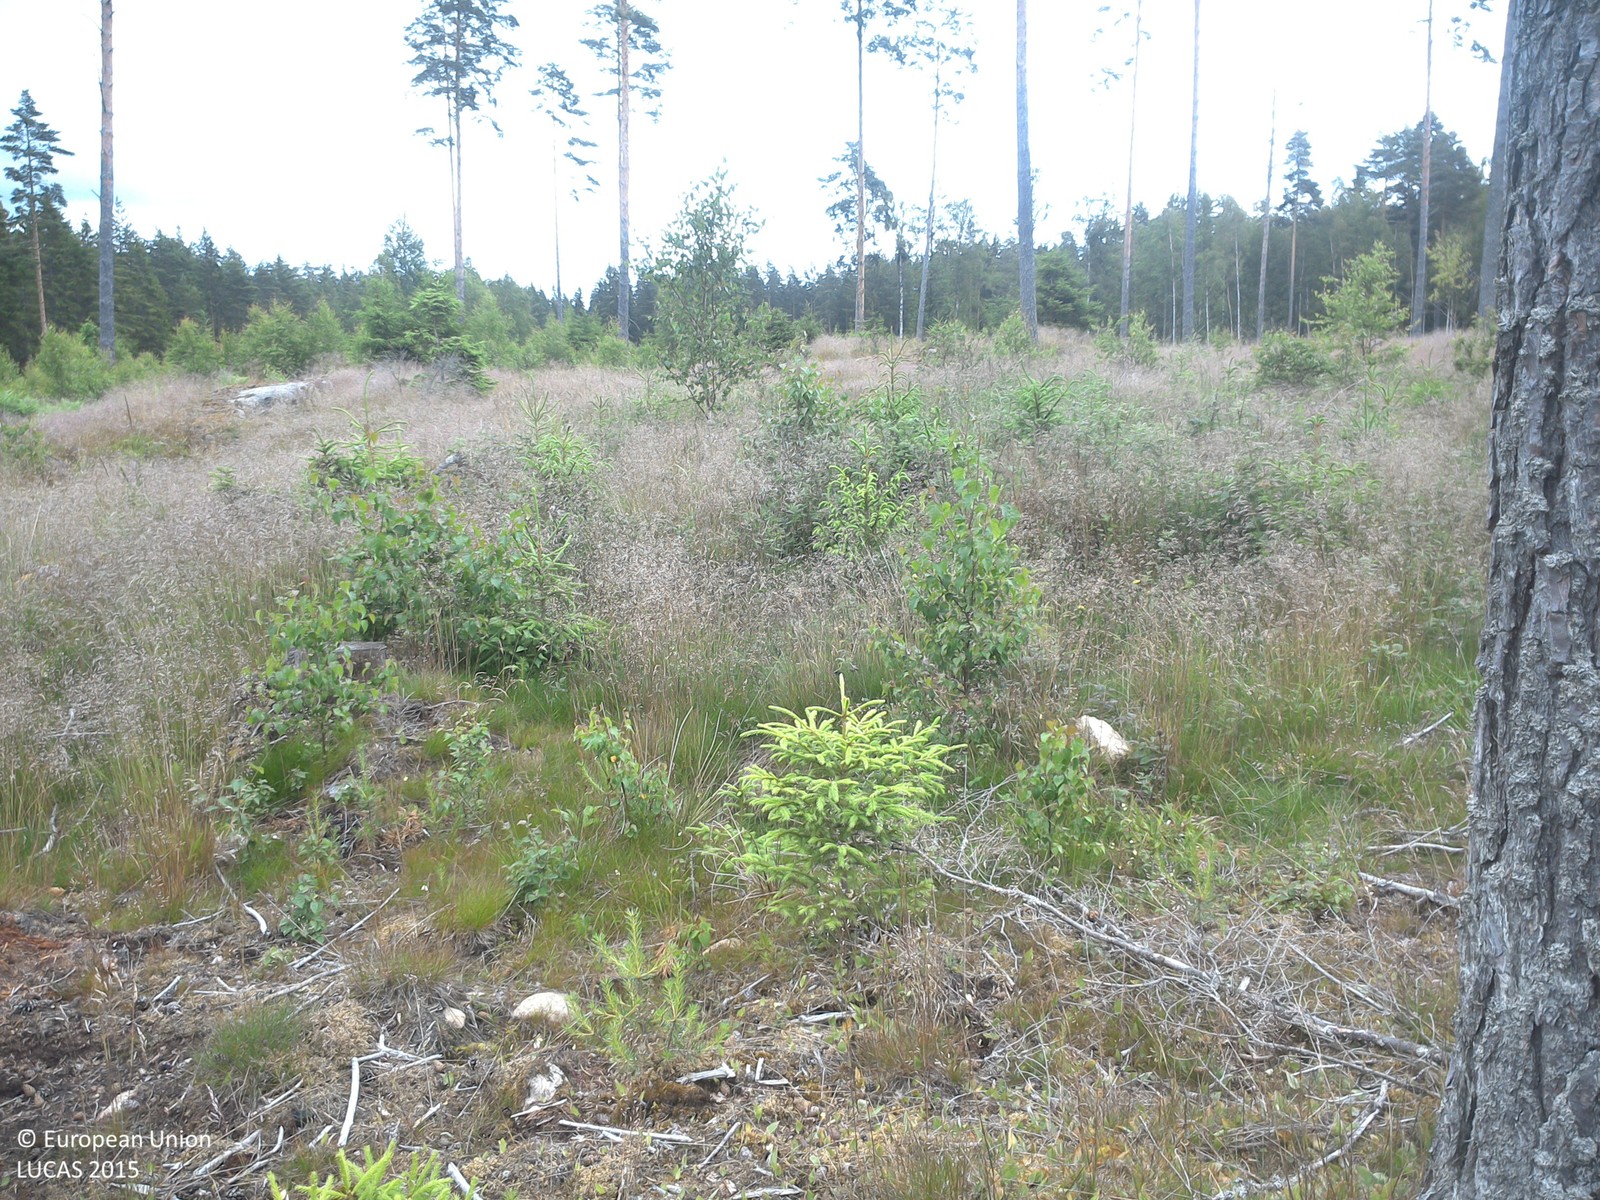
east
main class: Grassland
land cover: Grassland with sparse tree/shrub cover
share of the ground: < 10 %
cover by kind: herbaceous plants 70 %, lichens and mosses 15 %, shrubs 10 %, broadleaved forest trees 5 %
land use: Forestry
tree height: > 5 m
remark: Clear cut
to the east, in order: Grassland with sparse tree/shrub cover; Shrubland with sparse tree cover; Grassland with sparse tree/shrub cover; Tracks; Grassland with sparse tree/shrub cover; Broadleaved woodland; Ditches and canals; Spruce dominated mixed woodland; Paved roads, cycling and walking lanes; Pine dominated coniferous woodland
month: June
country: SE
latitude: 58.2830
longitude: 15.6057
